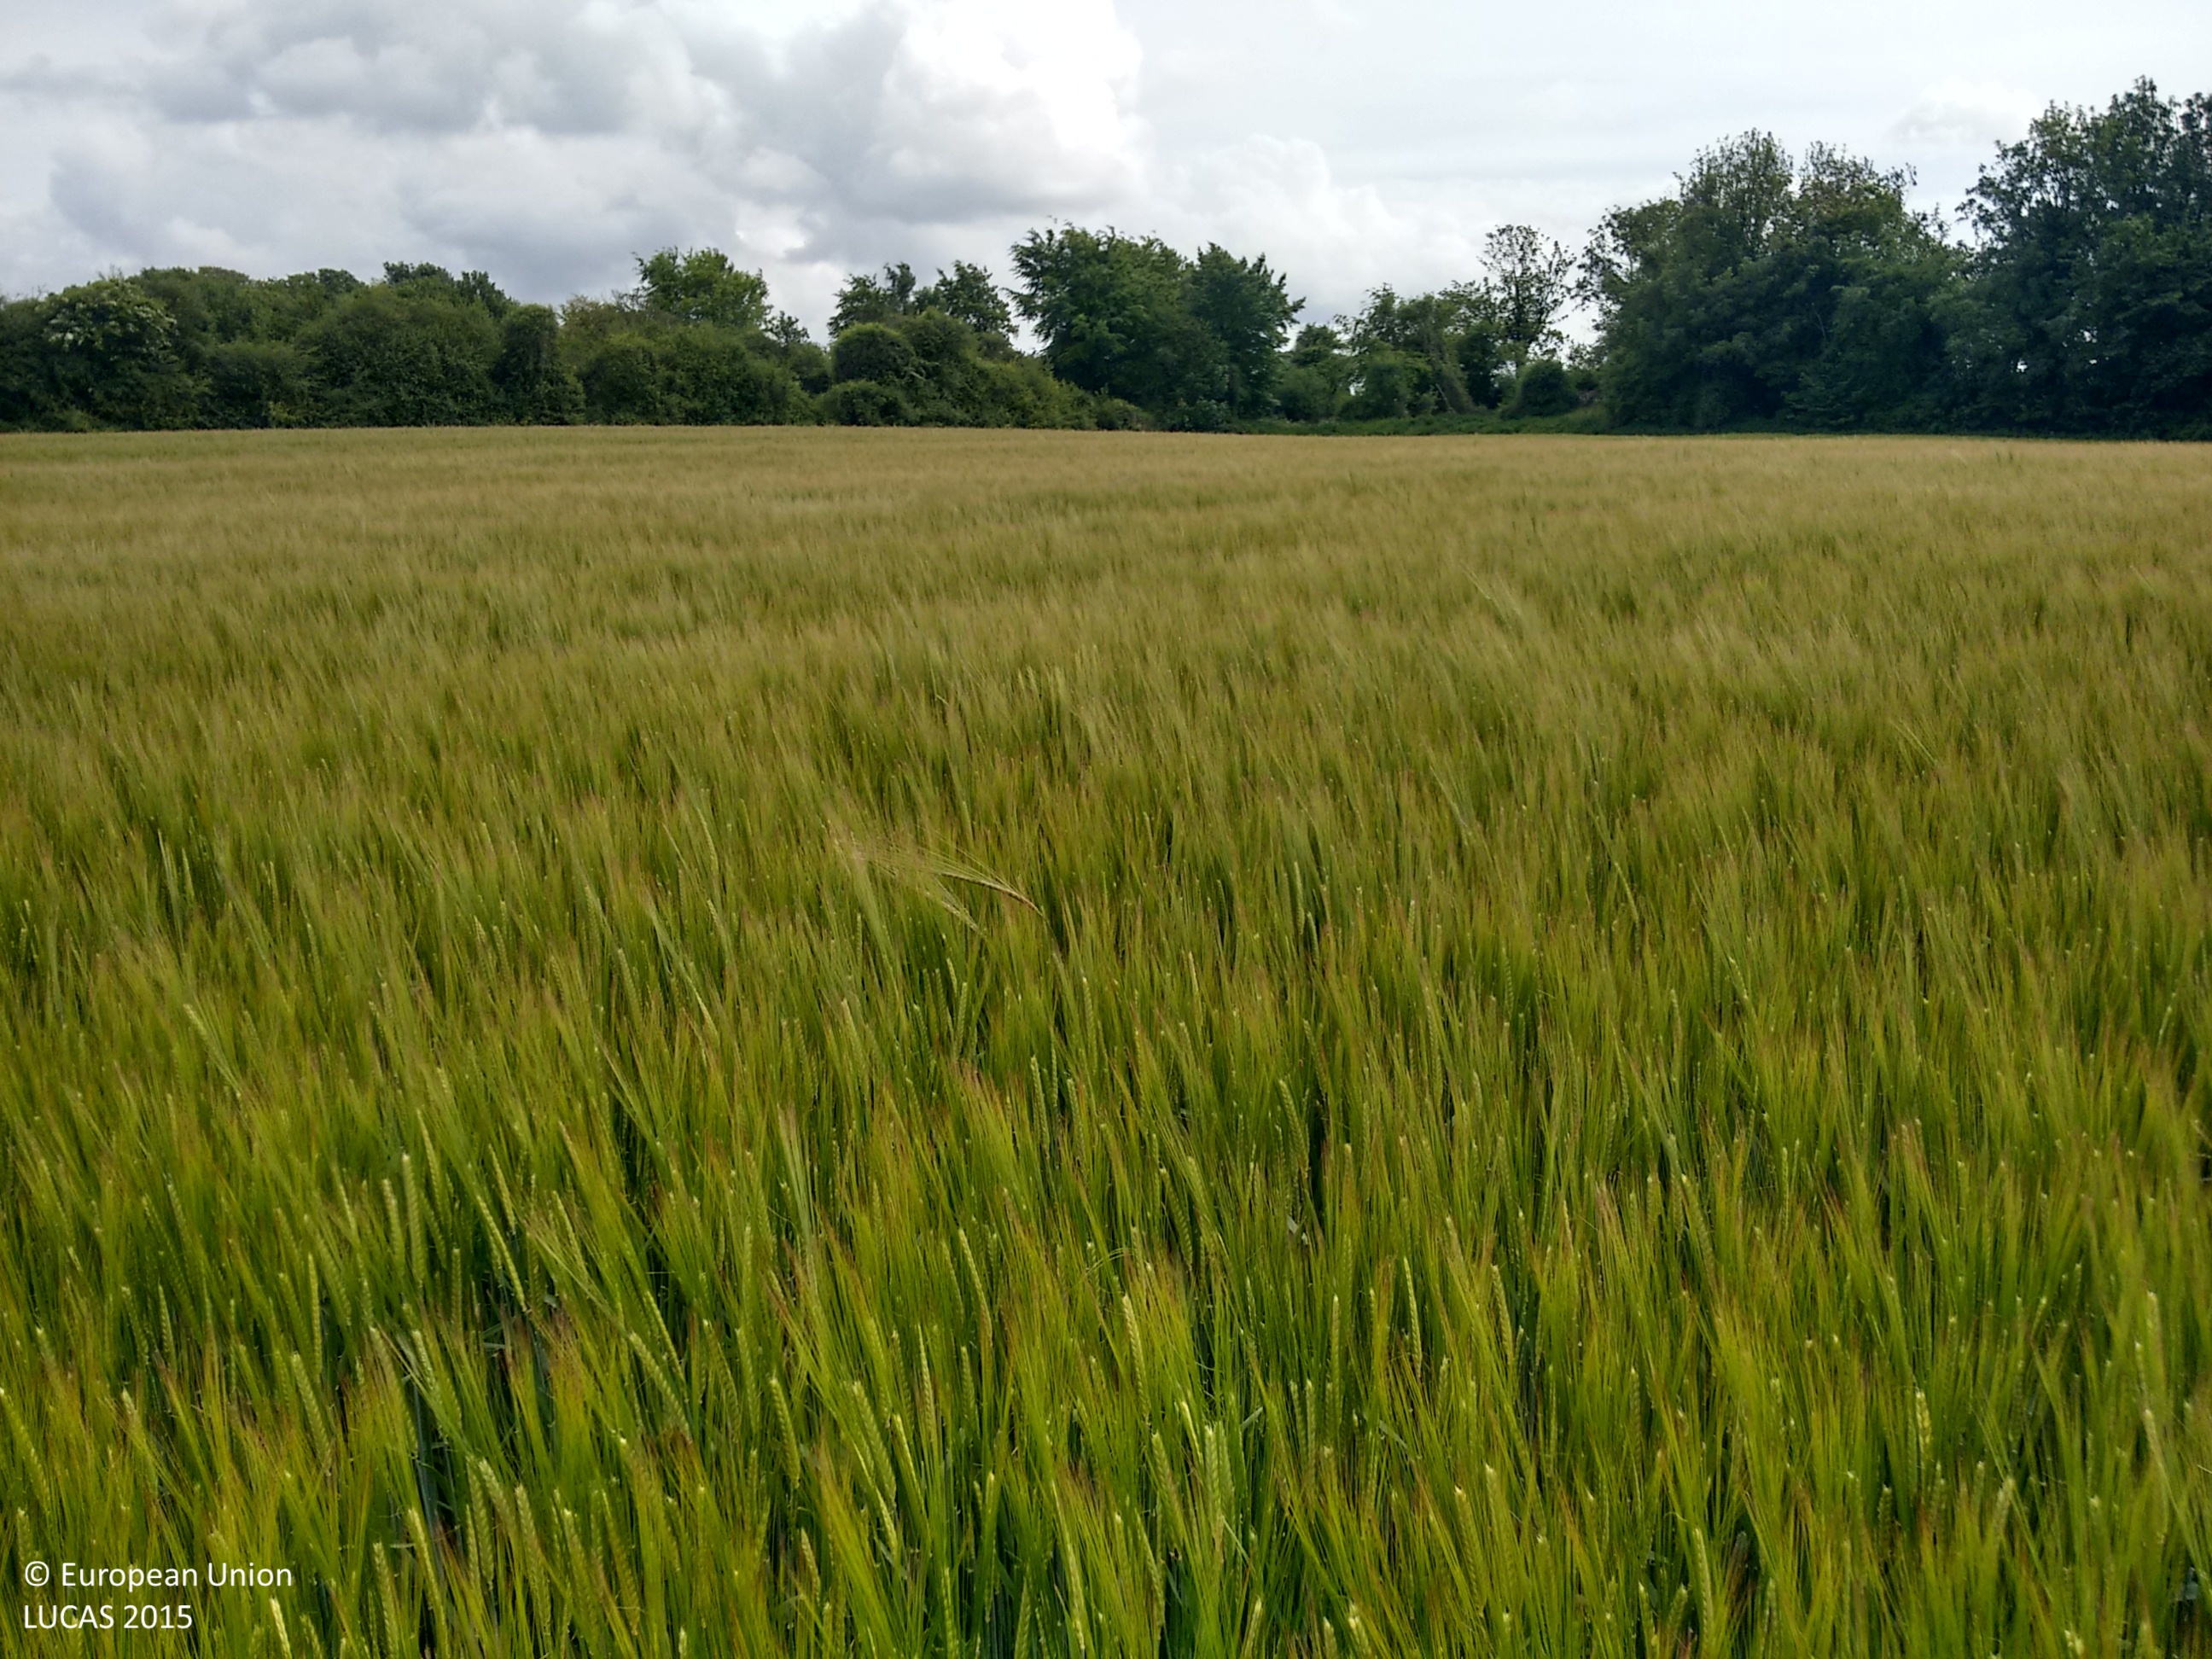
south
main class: Cropland
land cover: Barley
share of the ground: > 75 %
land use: Agriculture (excluding fallow land and kitchen gardens)
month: May
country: GB
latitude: 50.8328
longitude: -2.0569
